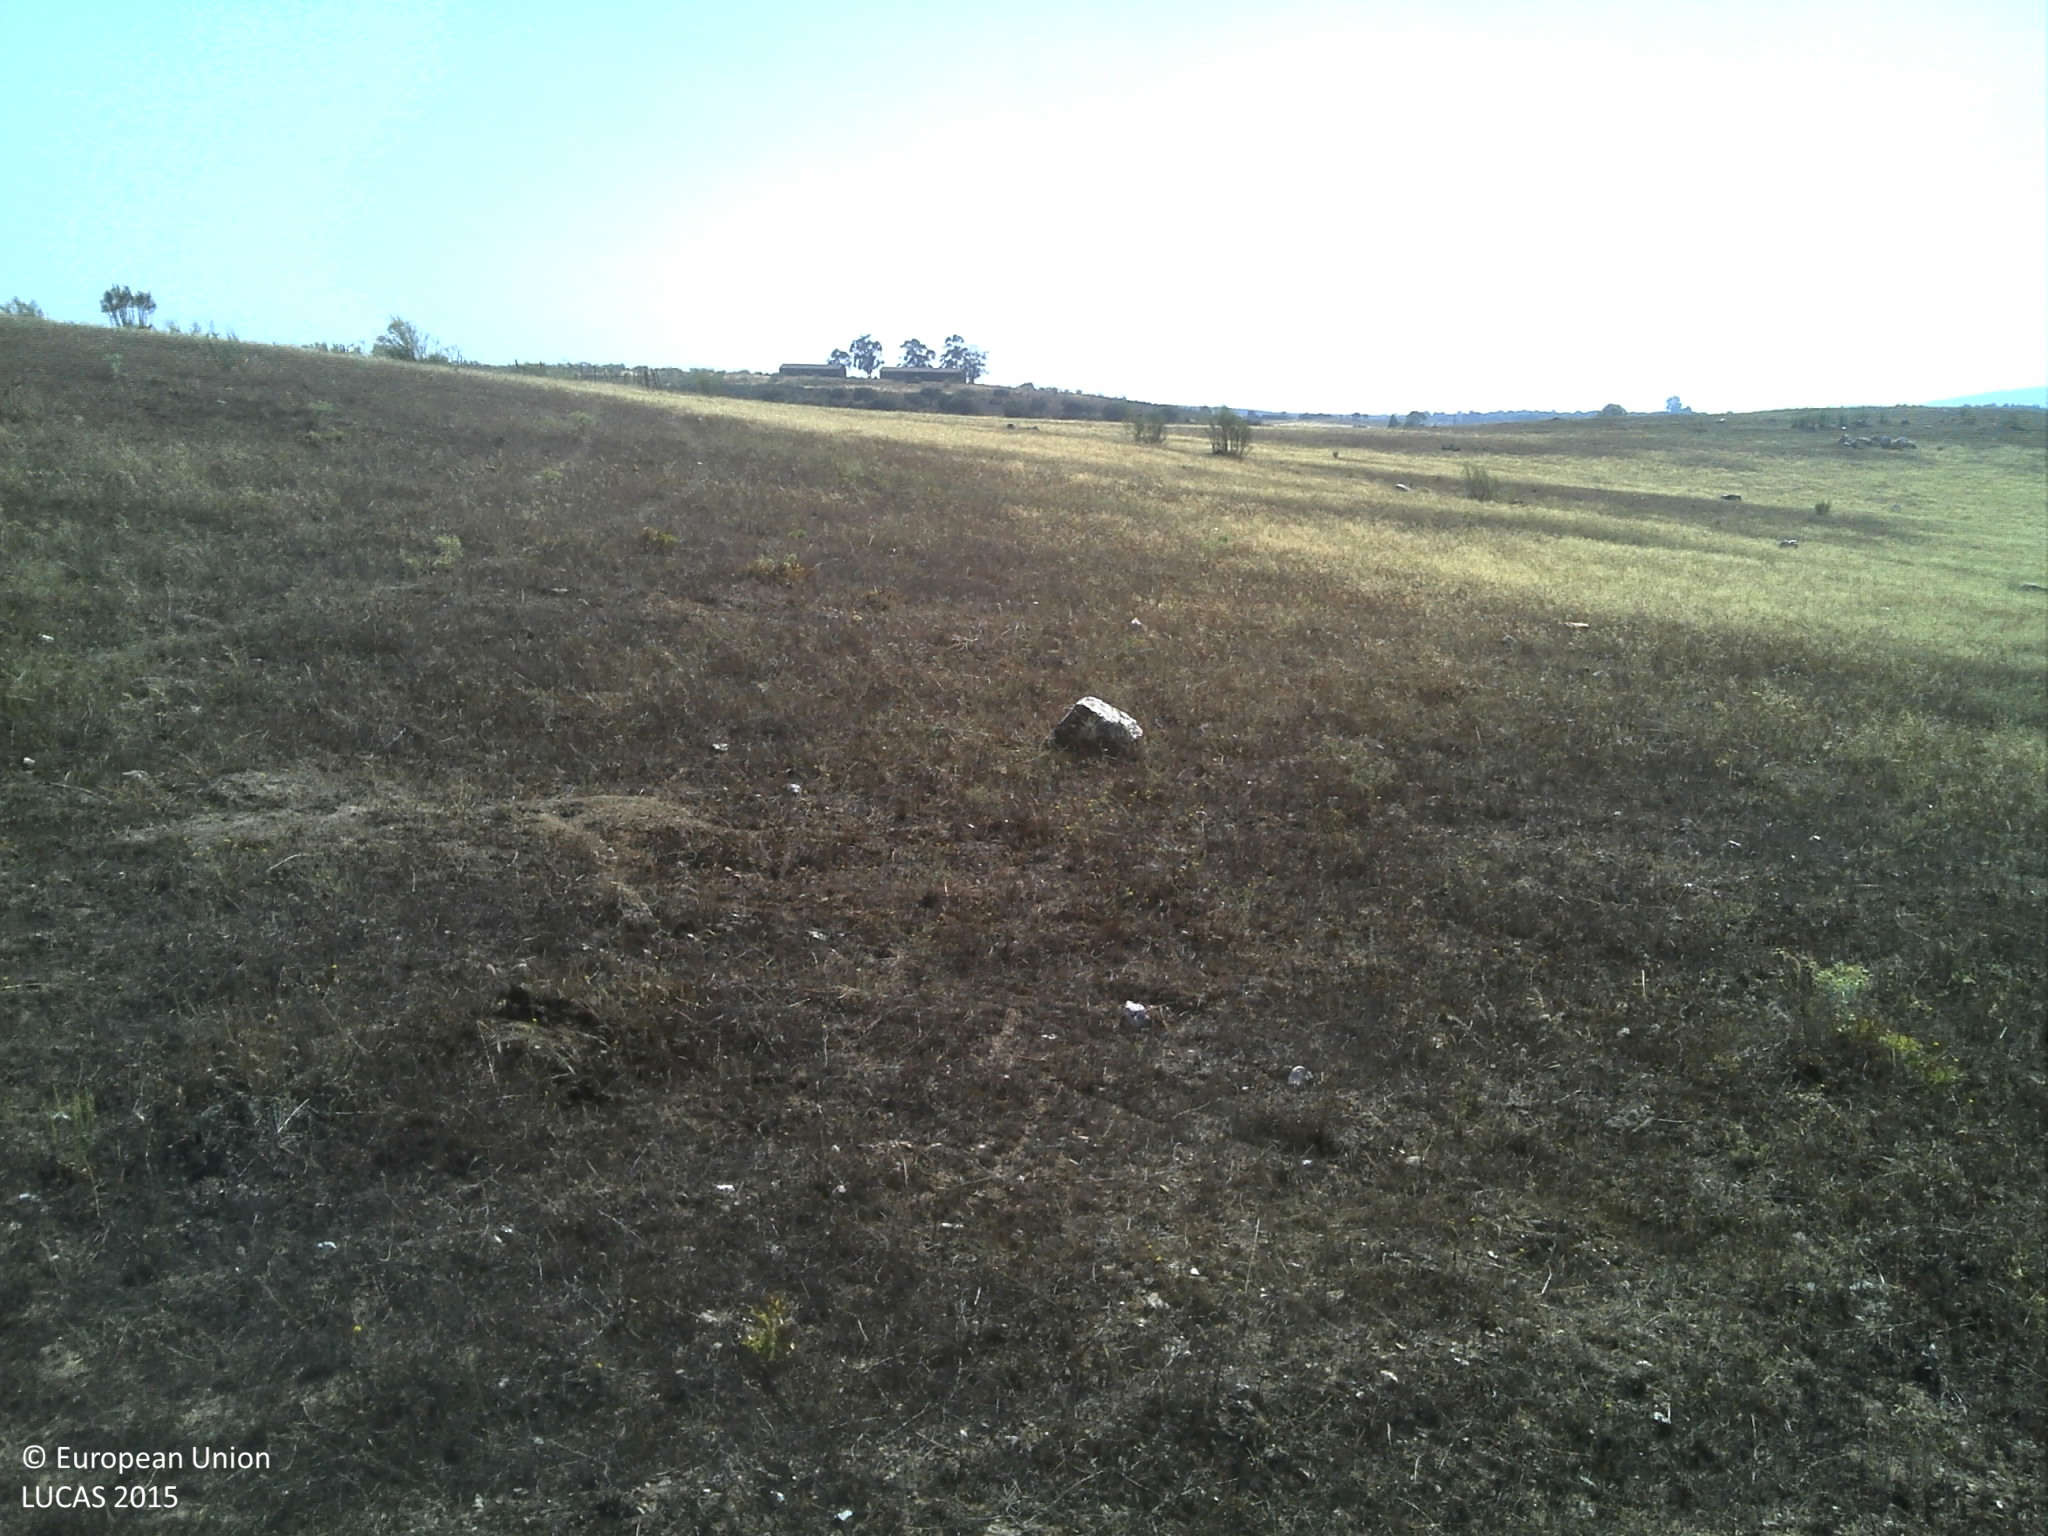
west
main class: Grassland
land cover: Grassland without tree/shrub cover
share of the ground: 25 - 50 %
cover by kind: unconsolidated bare surface 55 %, herbaceous plants 35 %, shrubs 5 %
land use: Agriculture (excluding fallow land and kitchen gardens)
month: June
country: PT
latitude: 39.9494
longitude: -6.9071
